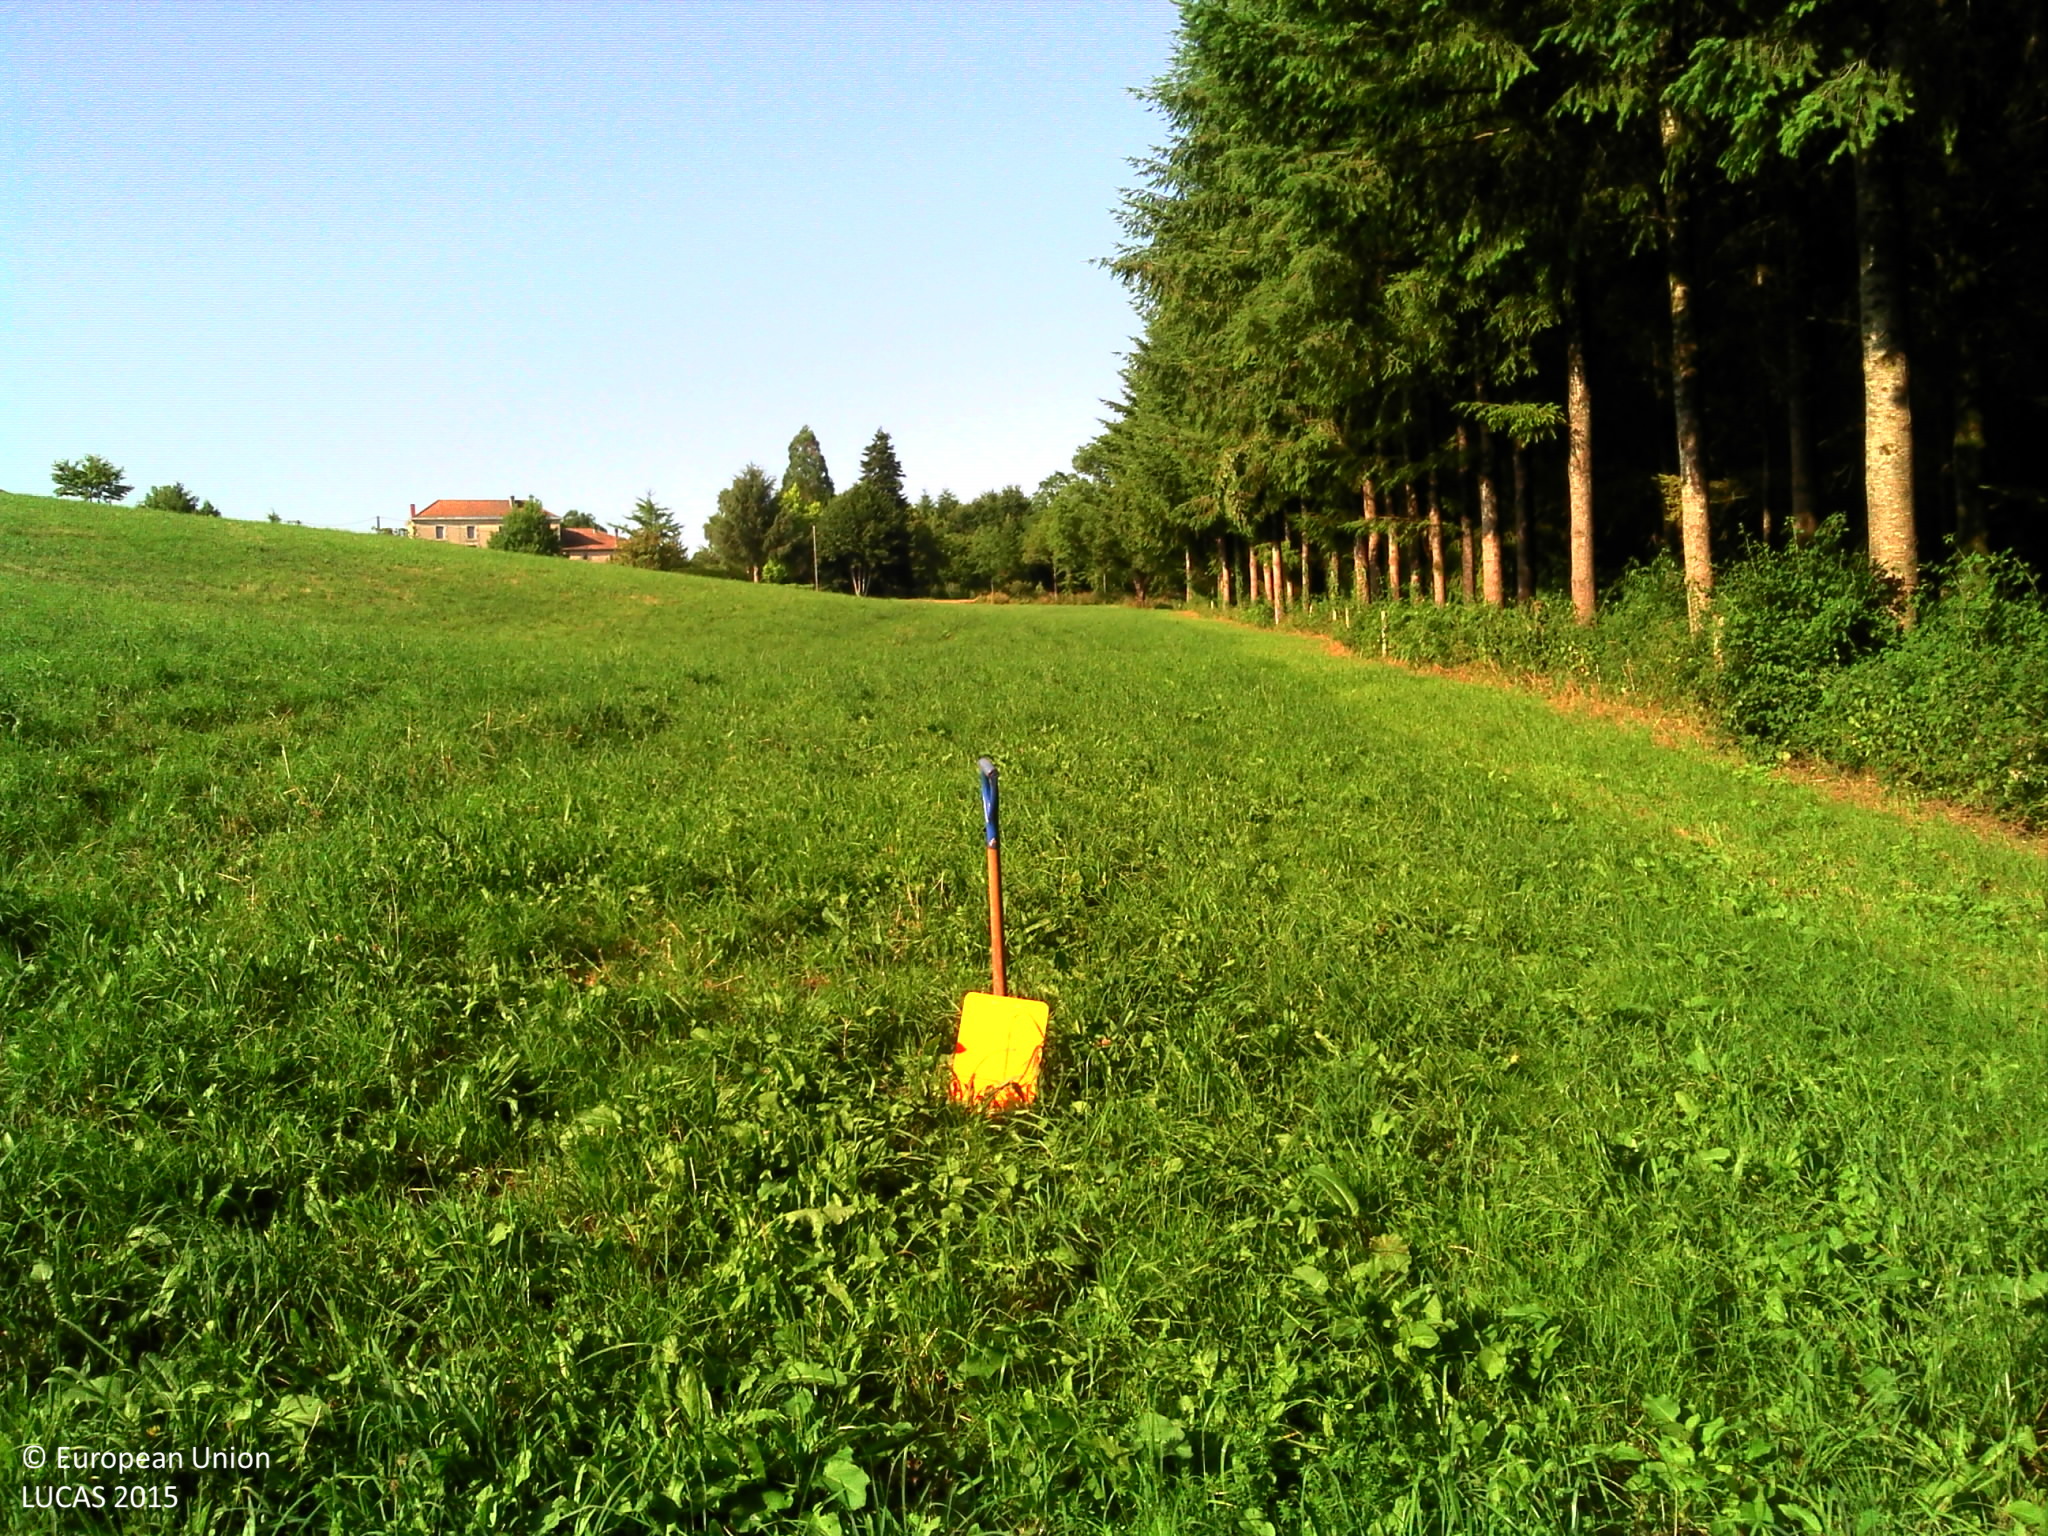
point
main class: Grassland
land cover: Grassland without tree/shrub cover
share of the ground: > 75 %
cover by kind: herbaceous plants 100 %
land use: Agriculture (excluding fallow land and kitchen gardens)
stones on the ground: < 10 %
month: June
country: FR
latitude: 45.7207
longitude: 0.6207
